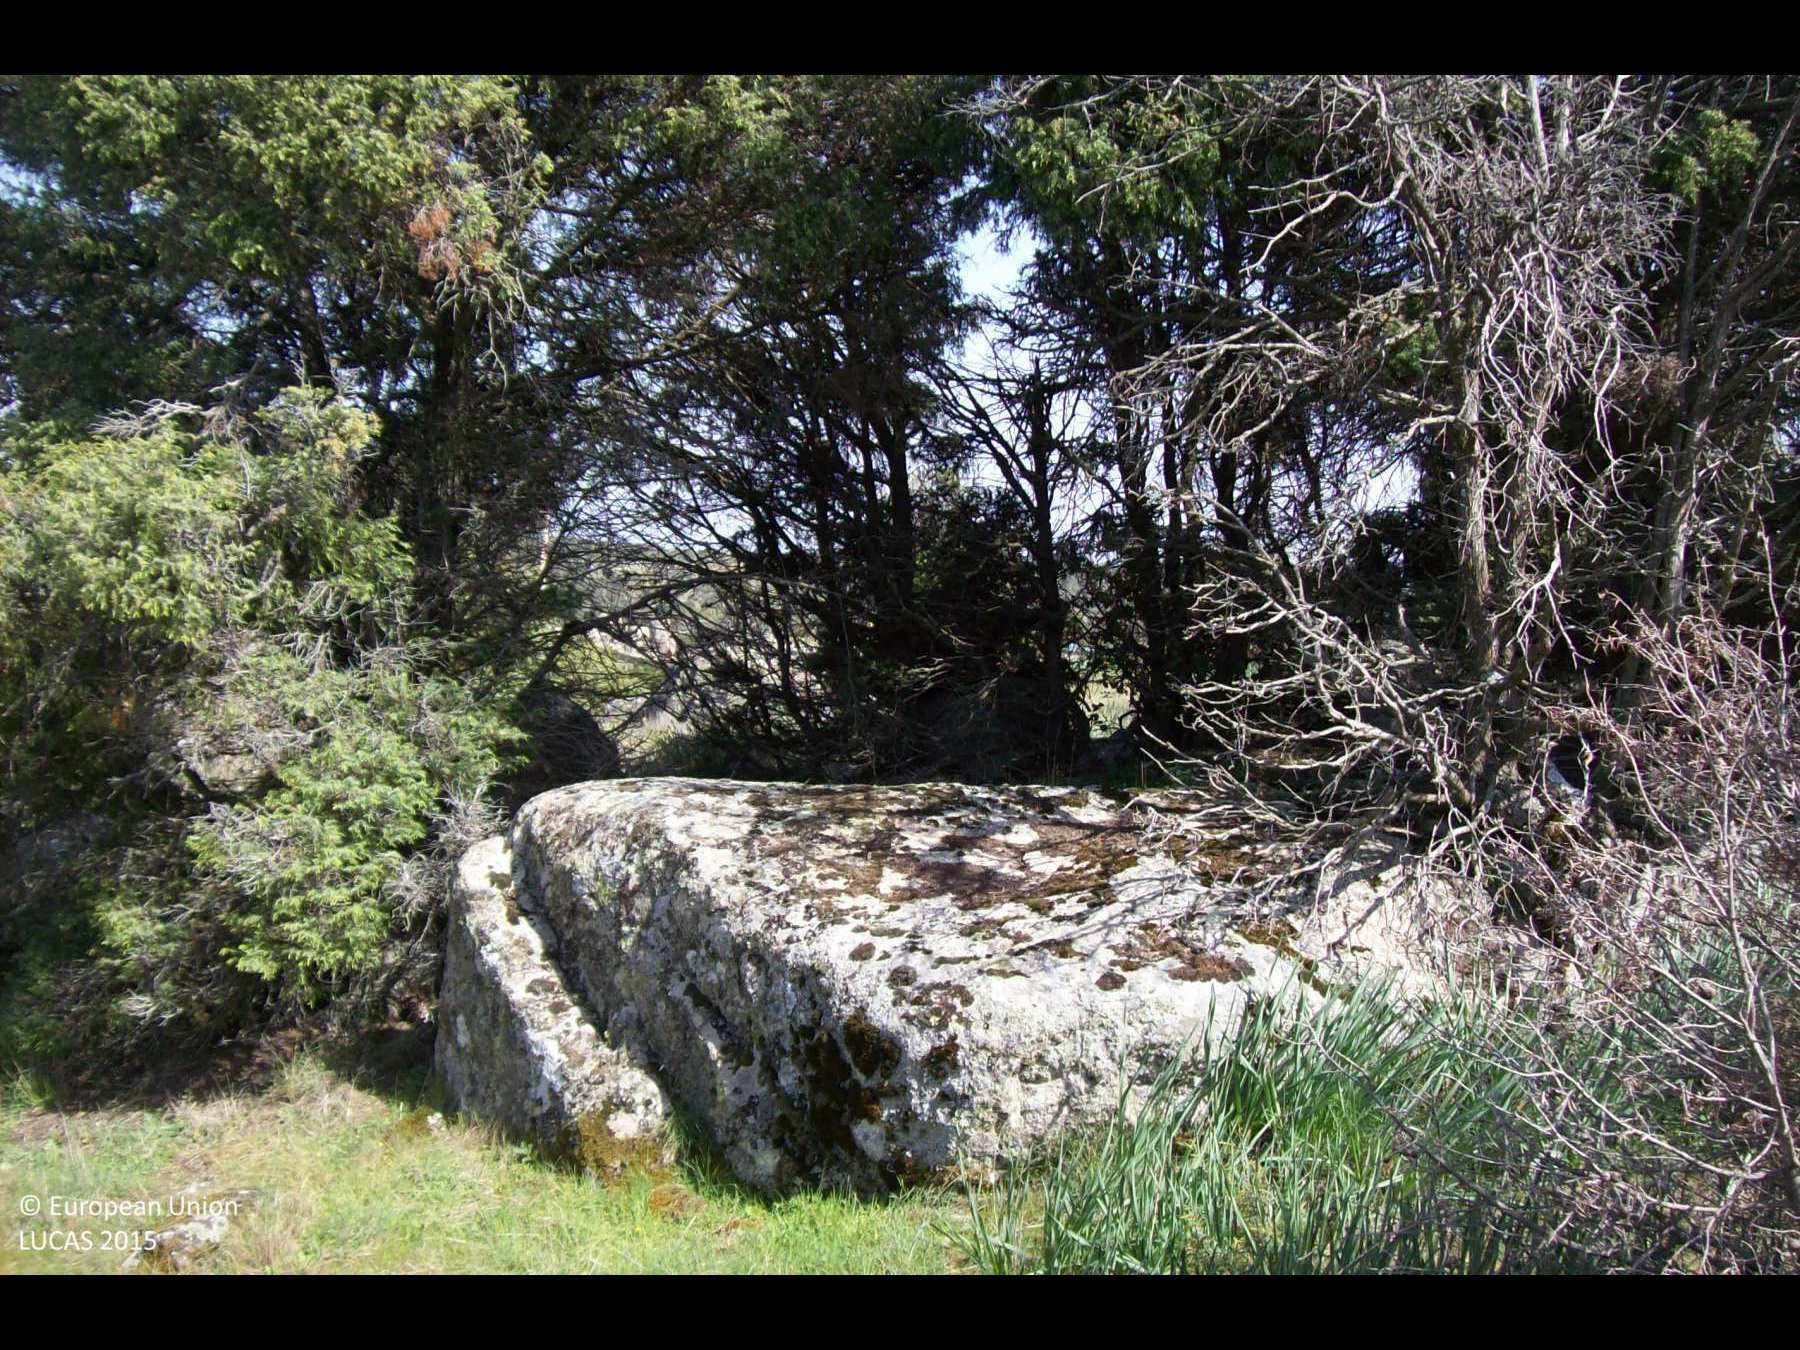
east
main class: Woodland
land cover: Other coniferous woodland
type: coniferous forest of the mediterranean region
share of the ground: > 75 %
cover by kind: herbaceous plants 35 %, coniferous forest trees 25 %, shrubs 20 %, consolidated bare surface 10 %
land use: Semi-natural and natural areas not in use
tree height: < 5 m
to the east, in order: Other coniferous woodland; Rock outcrops; Electric lines; Grassland with sparse tree/shrub cover; Grassland without tree/shrub cover; Dry stone walls; Grassland without tree/shrub cover; Tracks; Grassland with sparse tree/shrub cover; Artificial constructions in urban areas; Electric lines; Paved roads, cycling and walking lanes; Grassland without tree/shrub cover
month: April
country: ES
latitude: 40.6093
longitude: -3.9065
